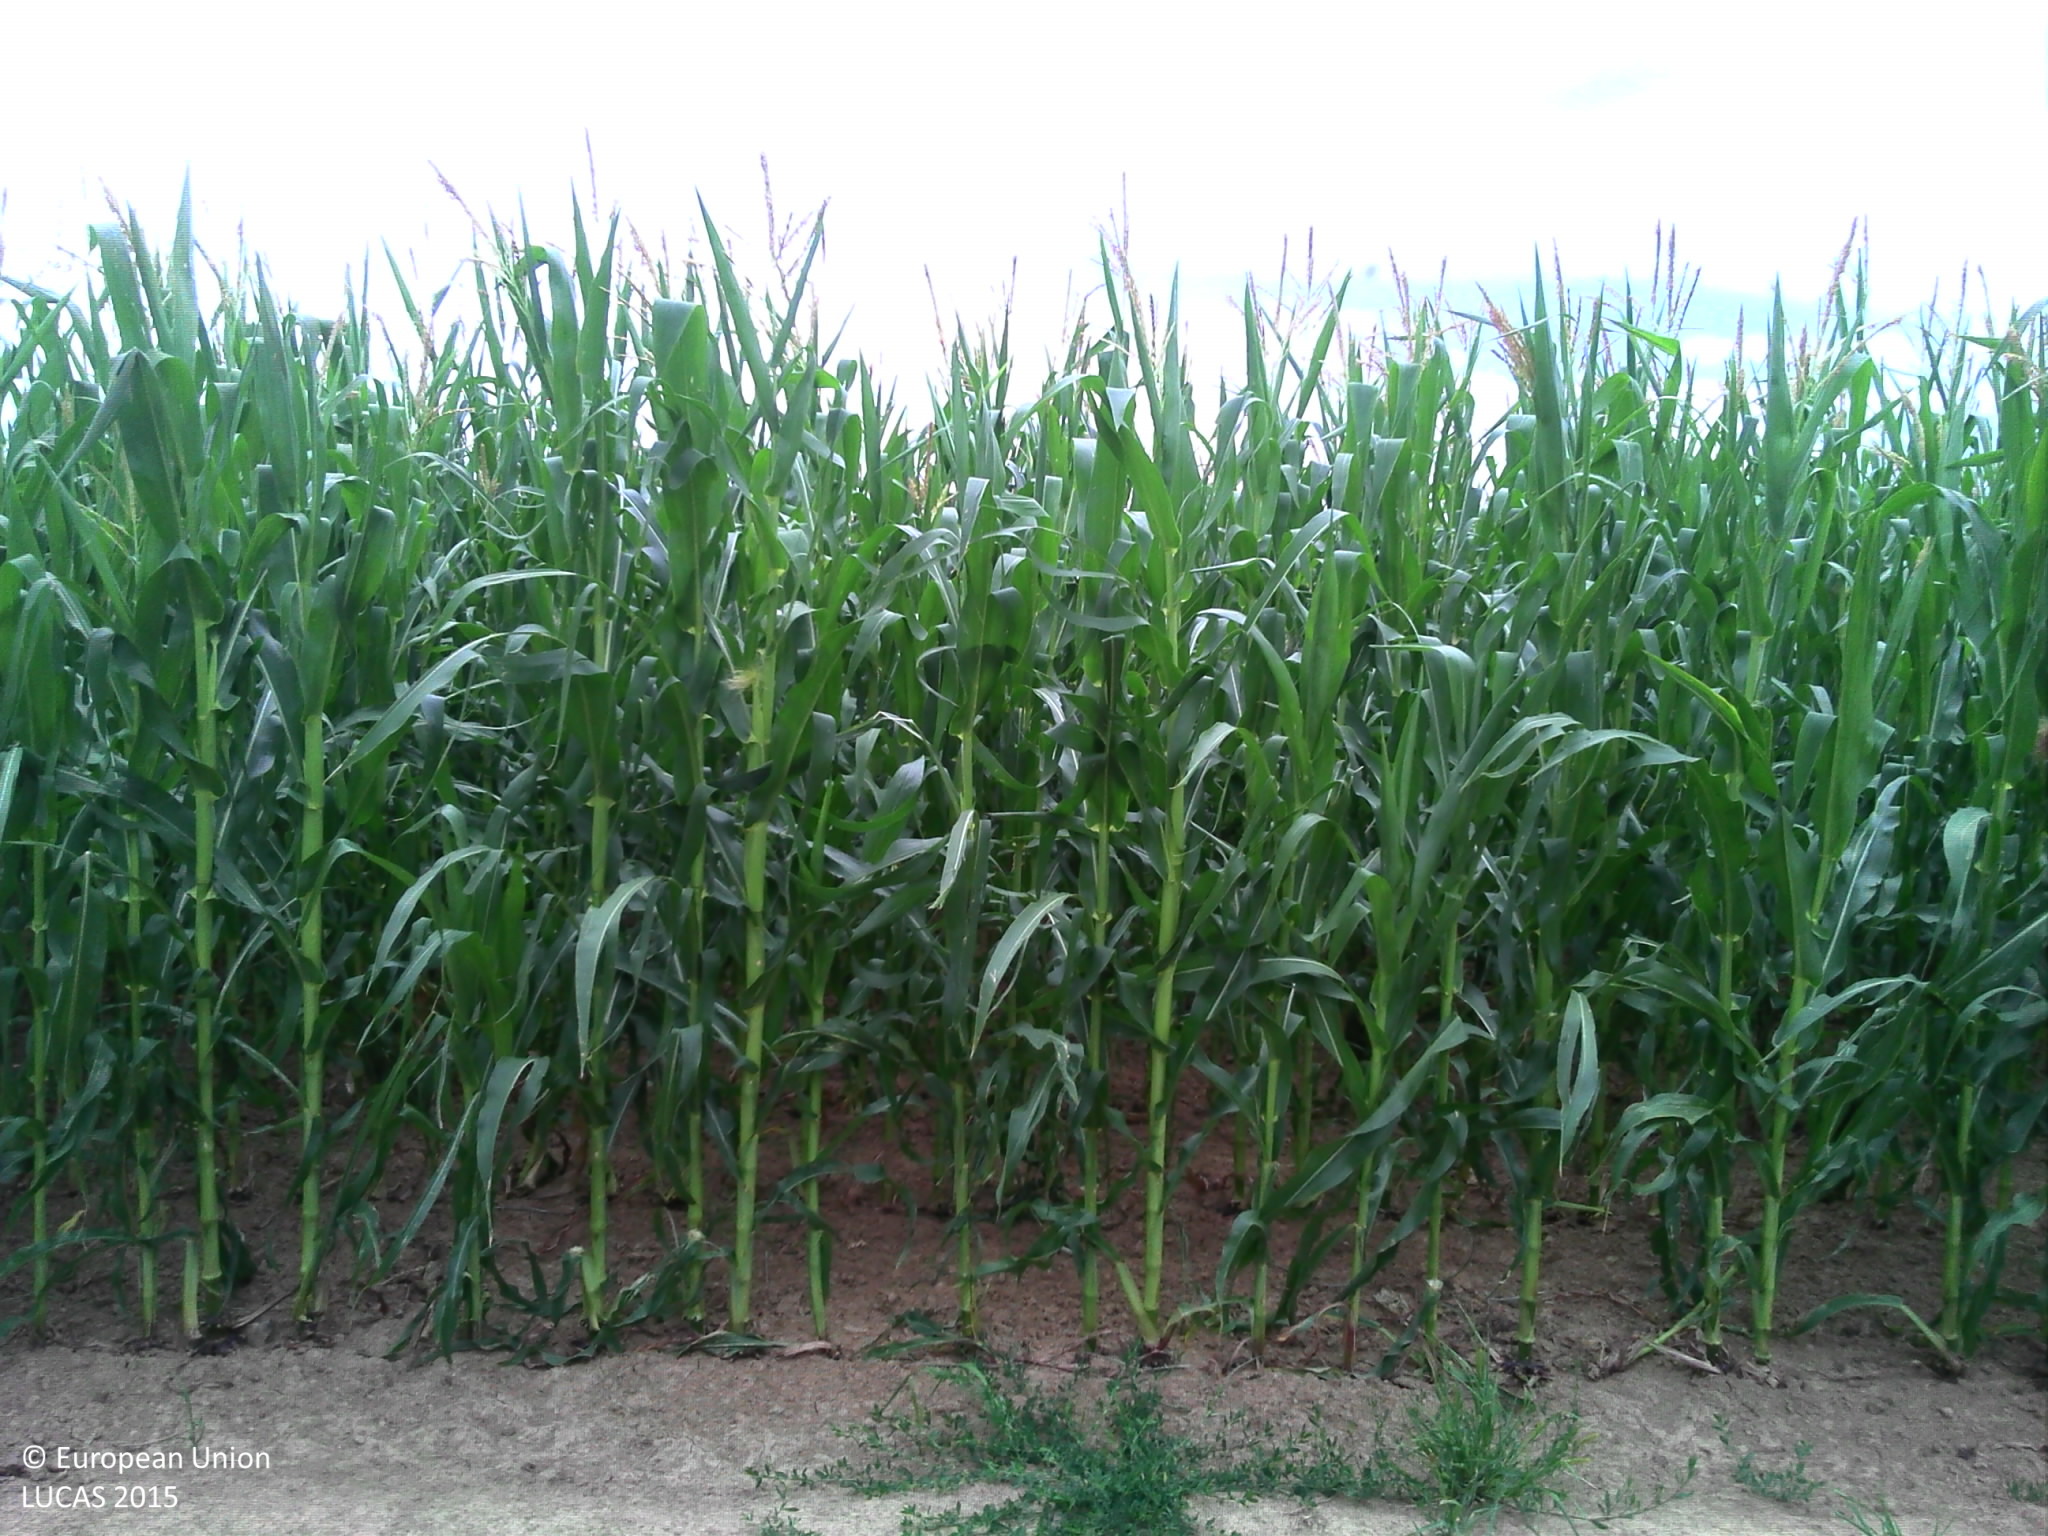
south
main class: Cropland
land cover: Maize
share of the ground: > 75 %
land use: Agriculture (excluding fallow land and kitchen gardens)
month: July
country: FR
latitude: 48.6474
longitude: 7.5983
